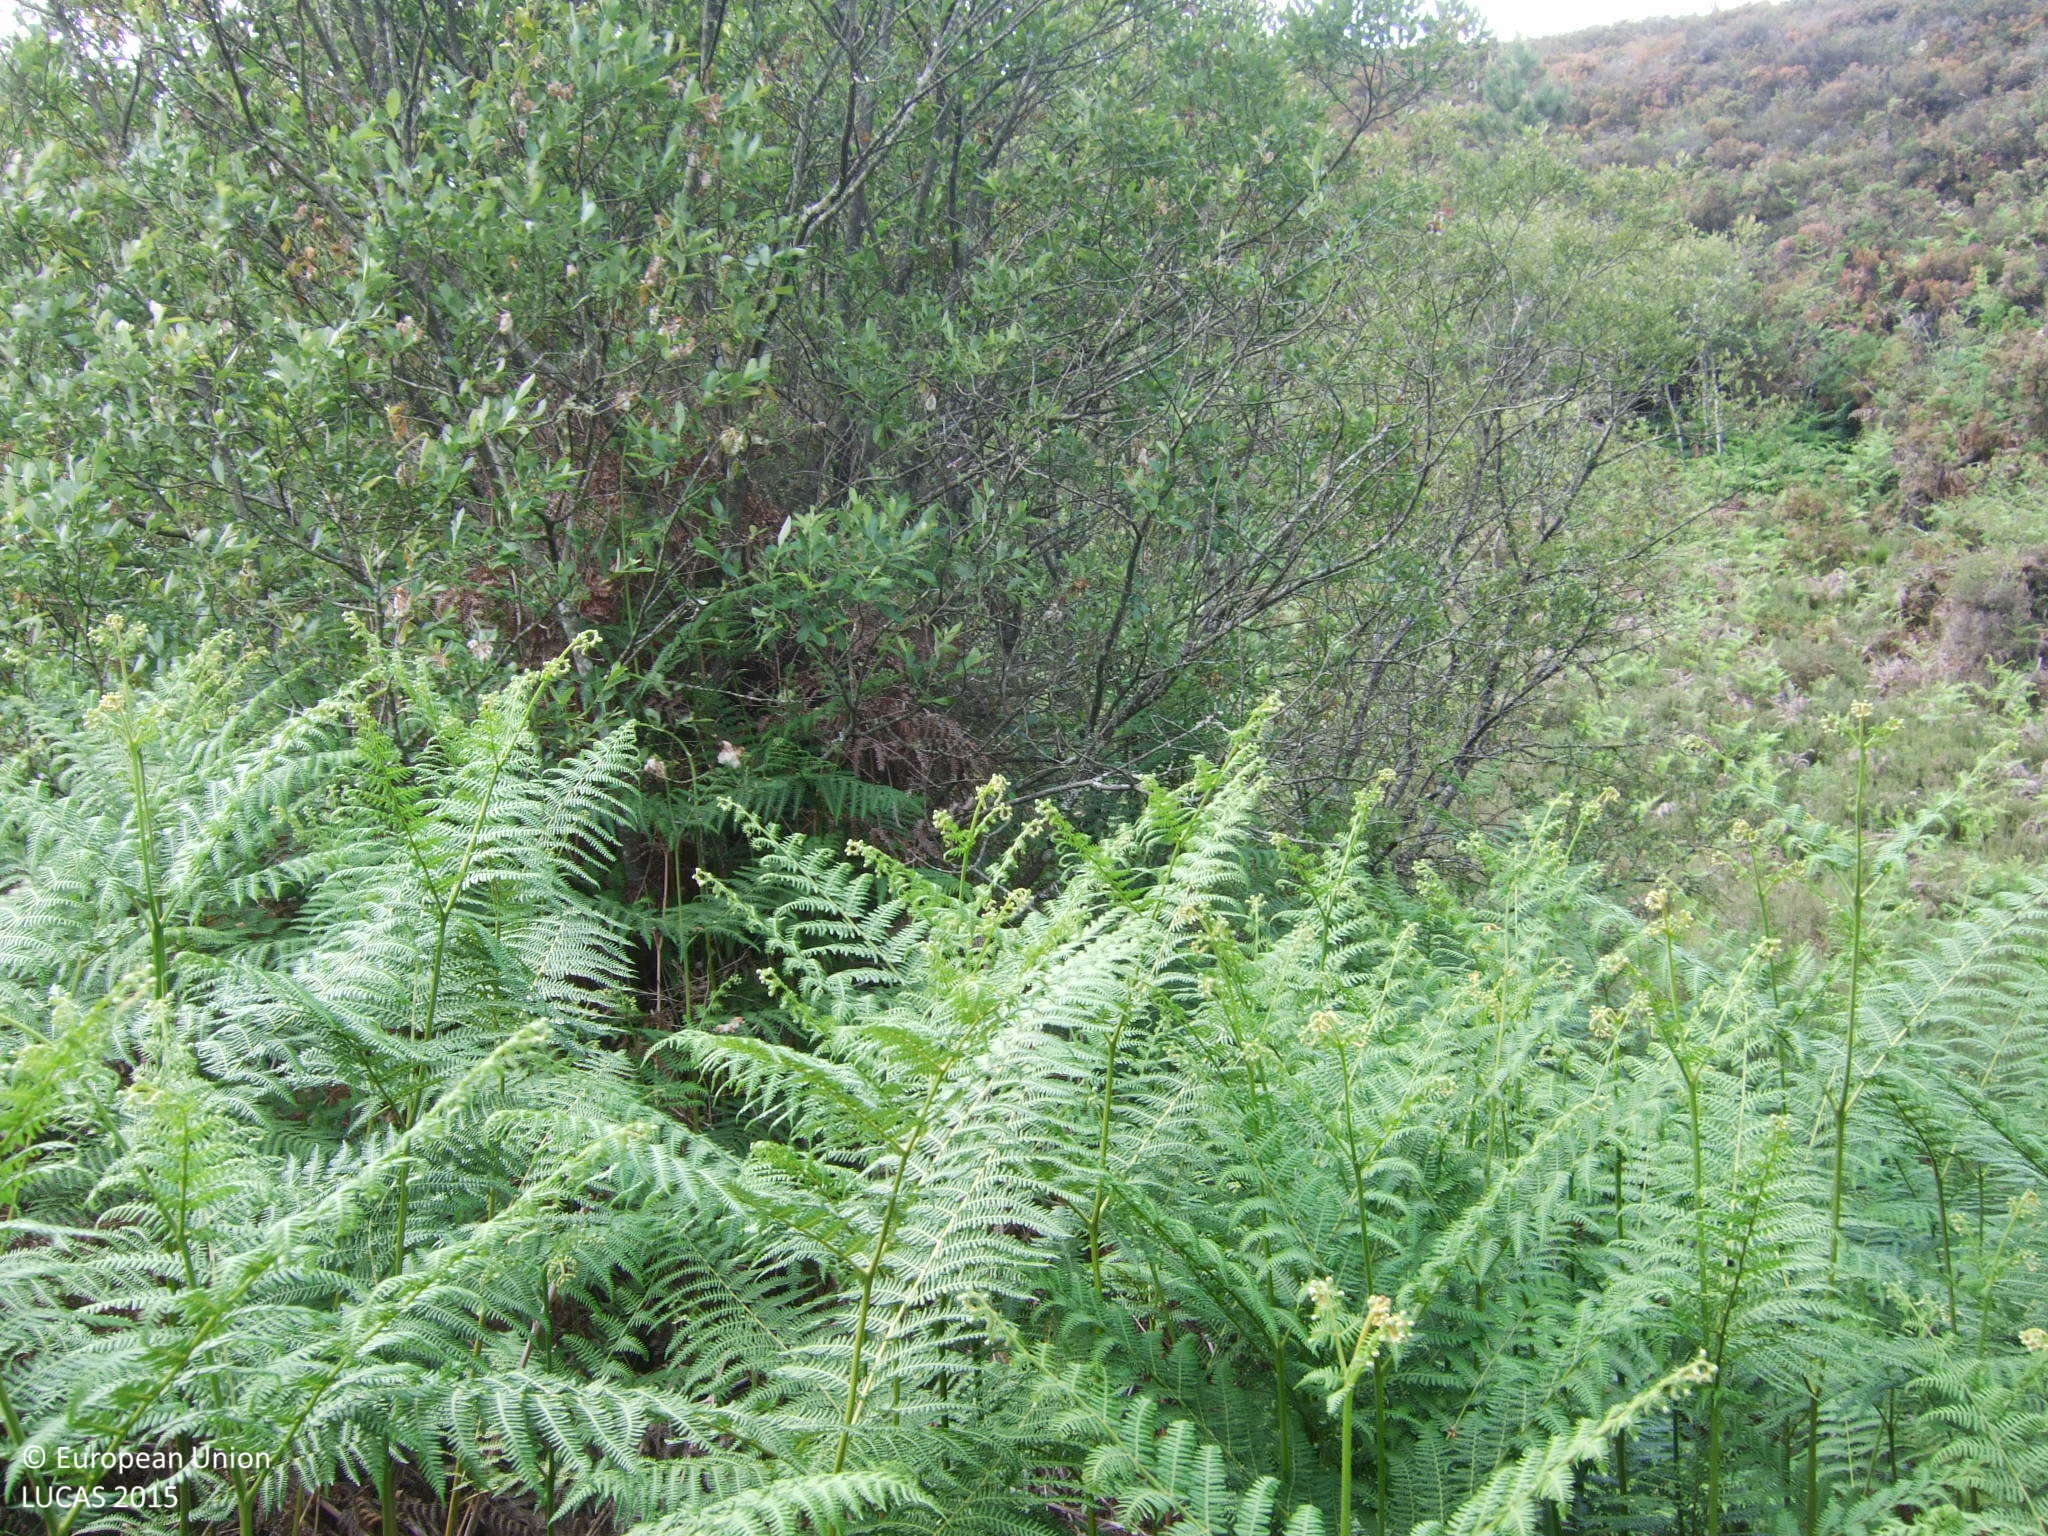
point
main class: Woodland
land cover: Broadleaved woodland
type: acidophilous oak and oak-birch forest
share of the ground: 10 - 25 %
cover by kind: shrubs 75 %, broadleaved forest trees 25 %
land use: Forestry
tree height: > 5 m
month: June
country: ES
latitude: 43.3636
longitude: -7.7197
